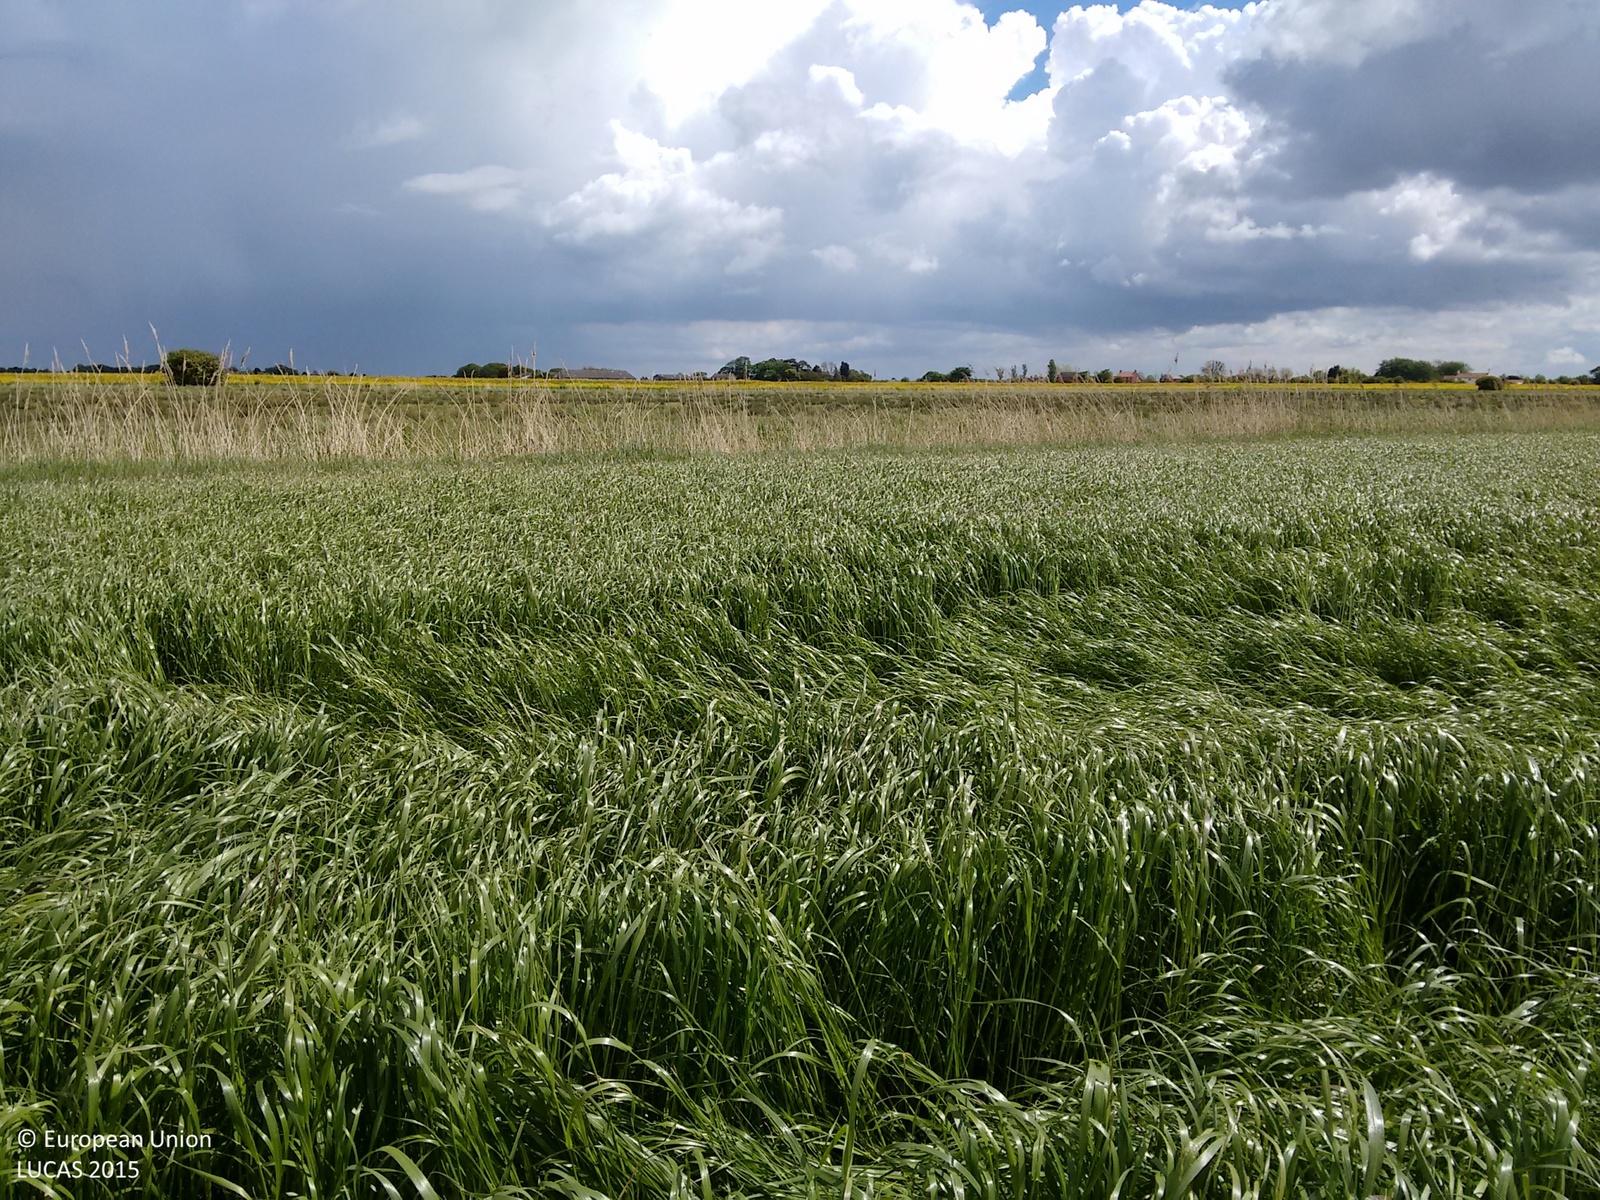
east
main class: Cropland
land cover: Common wheat
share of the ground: > 75 %
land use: Agriculture (excluding fallow land and kitchen gardens)
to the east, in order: Common wheat; Grass margins; Ditches and canals; Spontaneously vegetated surfaces; Ditches and canals; Grass margins; Rape and turnip rape
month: May
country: GB
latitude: 53.4004
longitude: 0.1789
